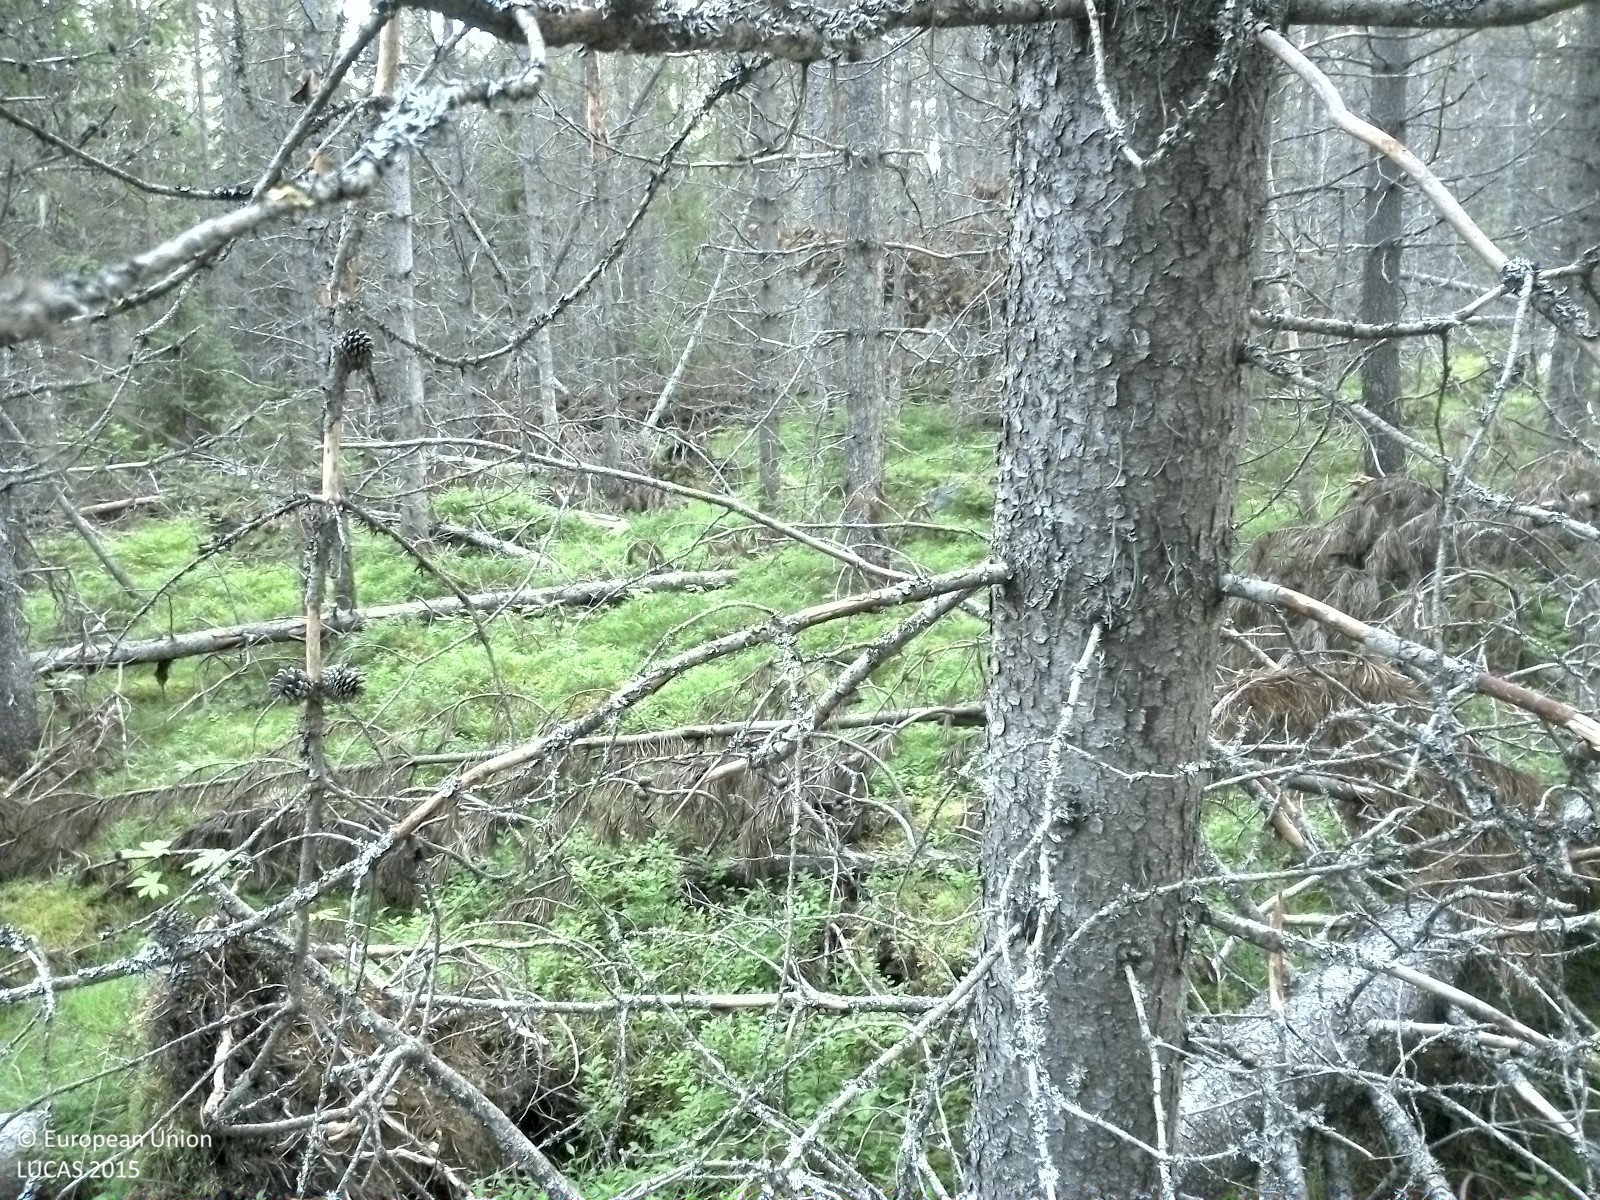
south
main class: Woodland
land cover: Pine dominated coniferous woodland
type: exotic forest
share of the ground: 50 - 75 %
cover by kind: coniferous forest trees 65 %, shrubs 25 %, lichens and mosses 10 %
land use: Forestry
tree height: > 5 m
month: August
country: SE
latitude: 62.7420
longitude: 16.5343
